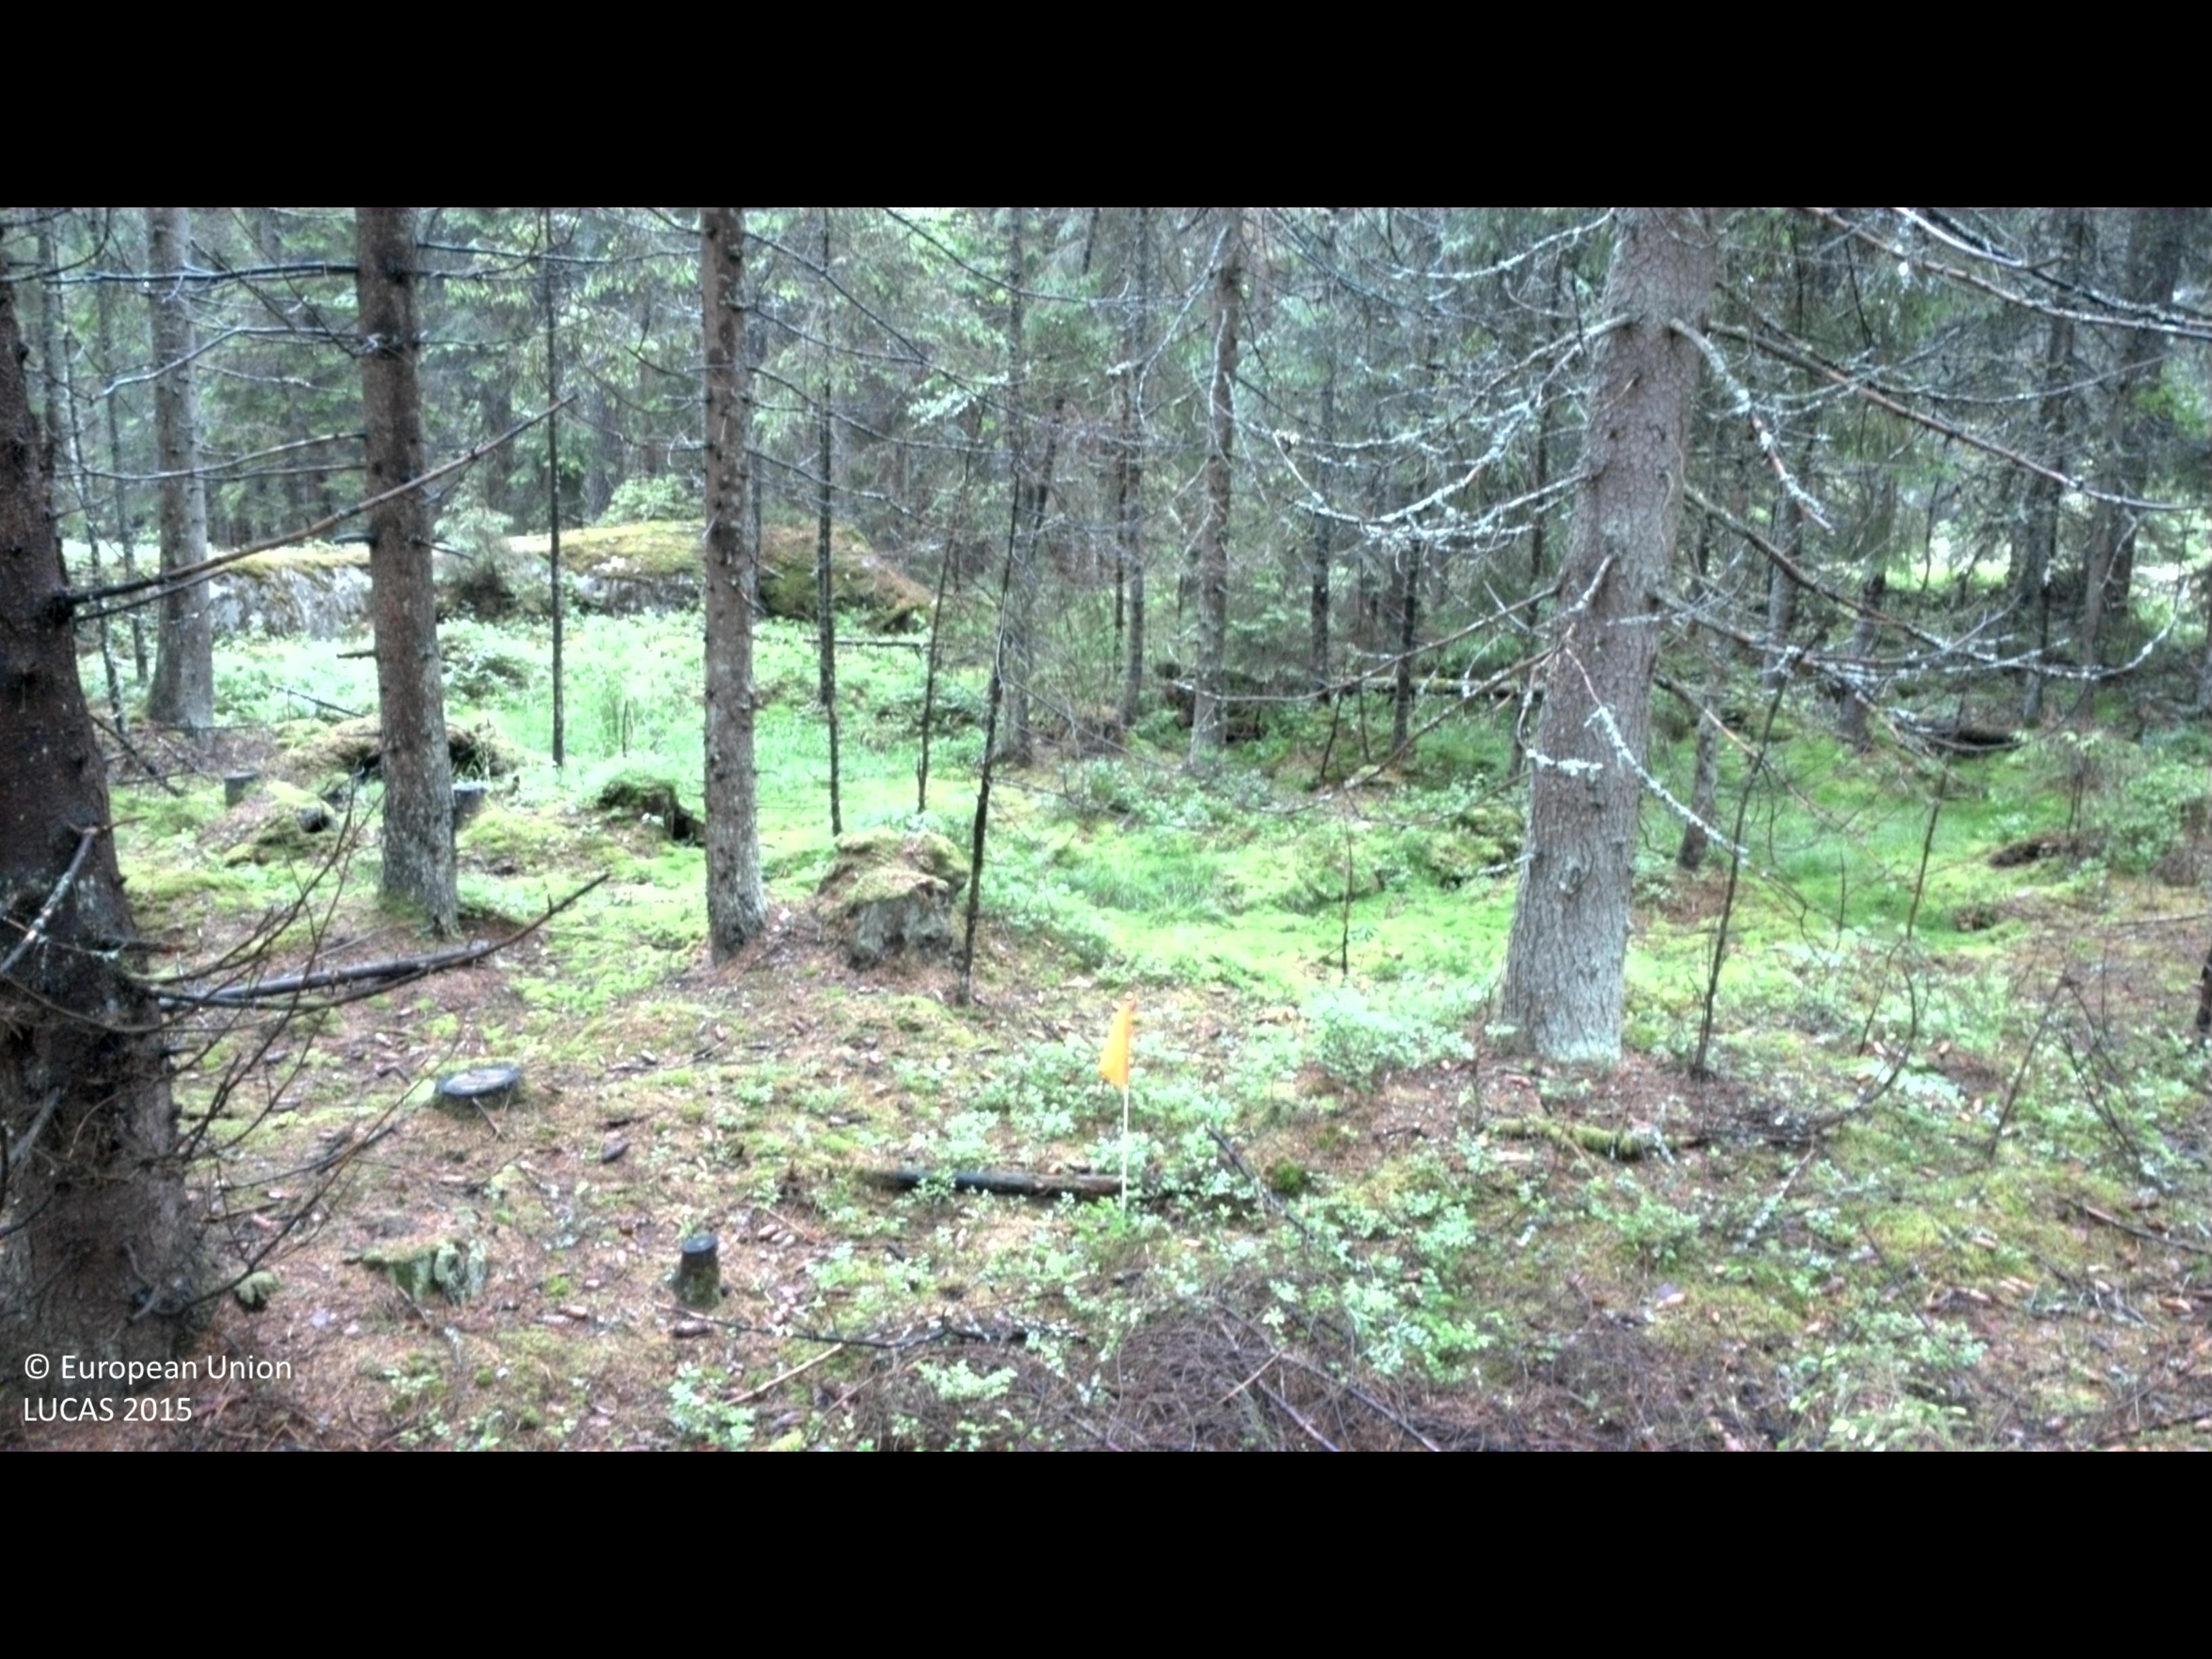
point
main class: Woodland
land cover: Spruce dominated coniferous woodland
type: boreal forest
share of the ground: 50 - 75 %
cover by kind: coniferous forest trees 75 %, shrubs 15 %, lichens and mosses 10 %
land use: Forestry
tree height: > 5 m
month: June
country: SE
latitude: 58.0514
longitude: 16.3510
